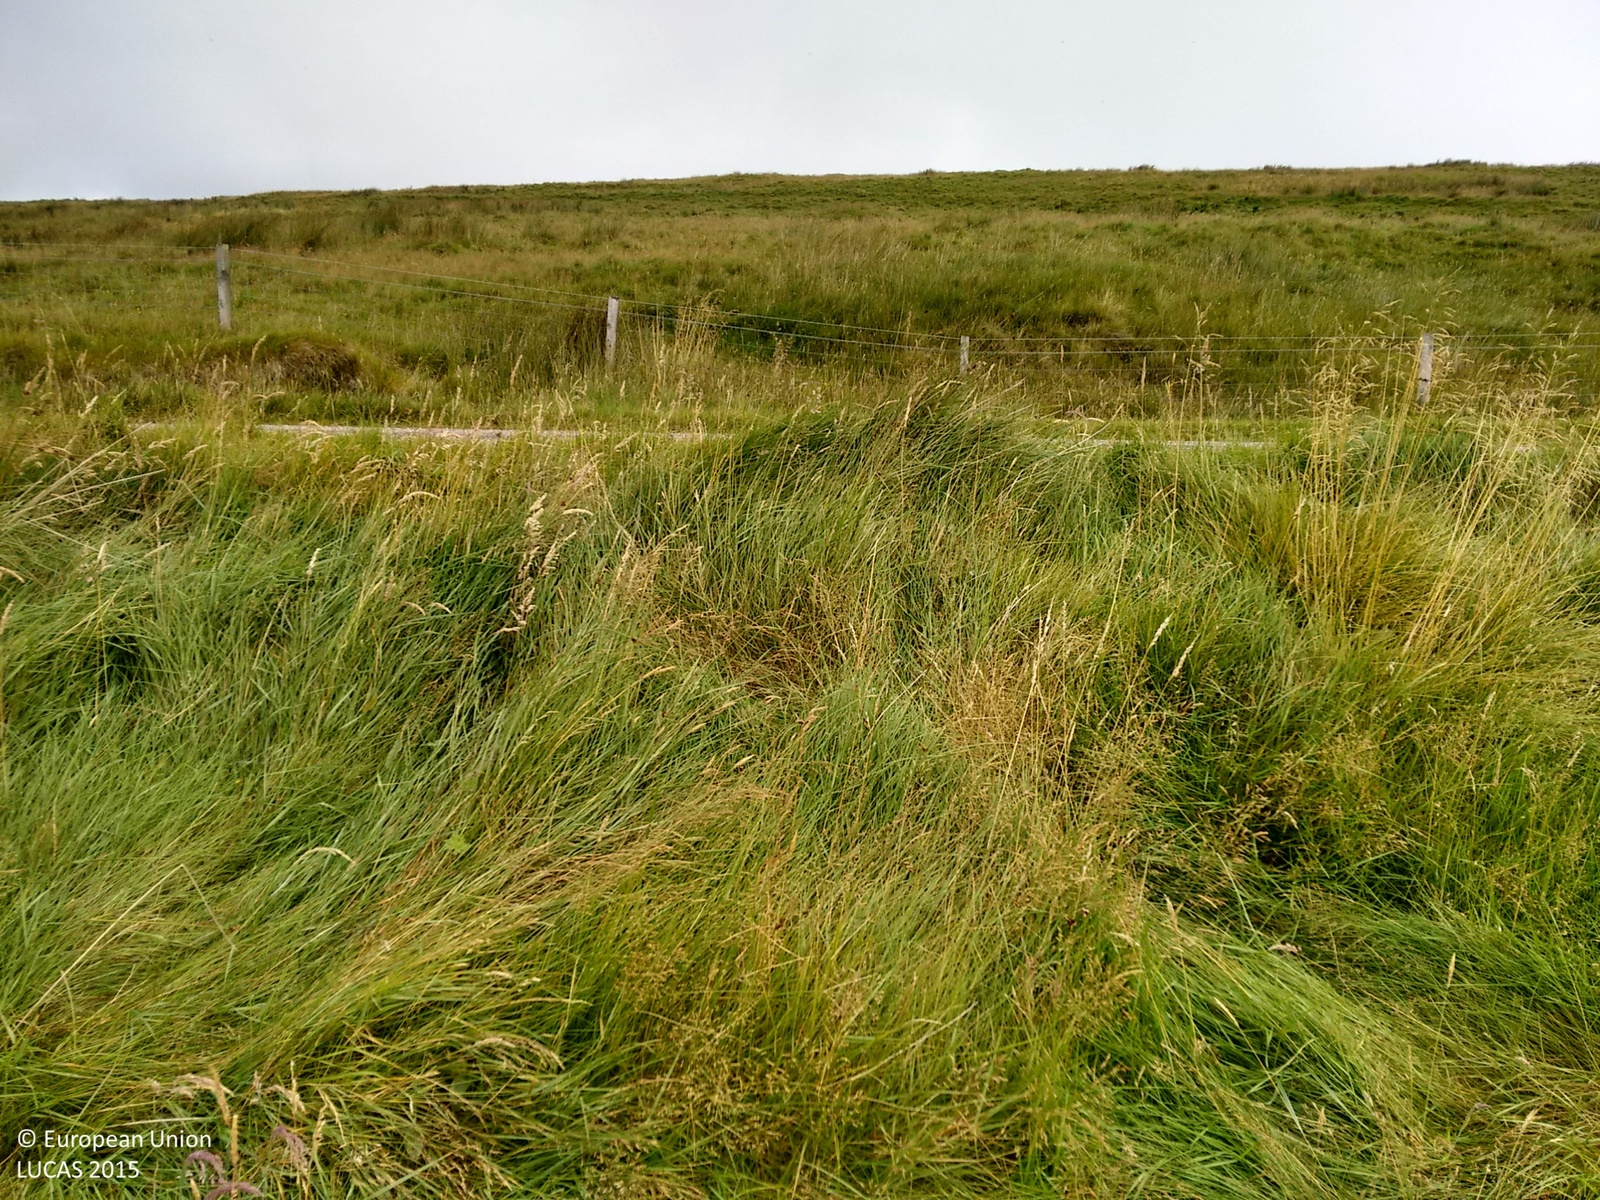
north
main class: Grassland
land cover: Grassland without tree/shrub cover
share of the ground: > 75 %
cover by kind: herbaceous plants 100 %
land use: Agriculture (excluding fallow land and kitchen gardens)
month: September
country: GB
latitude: 58.2886
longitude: -4.4993
